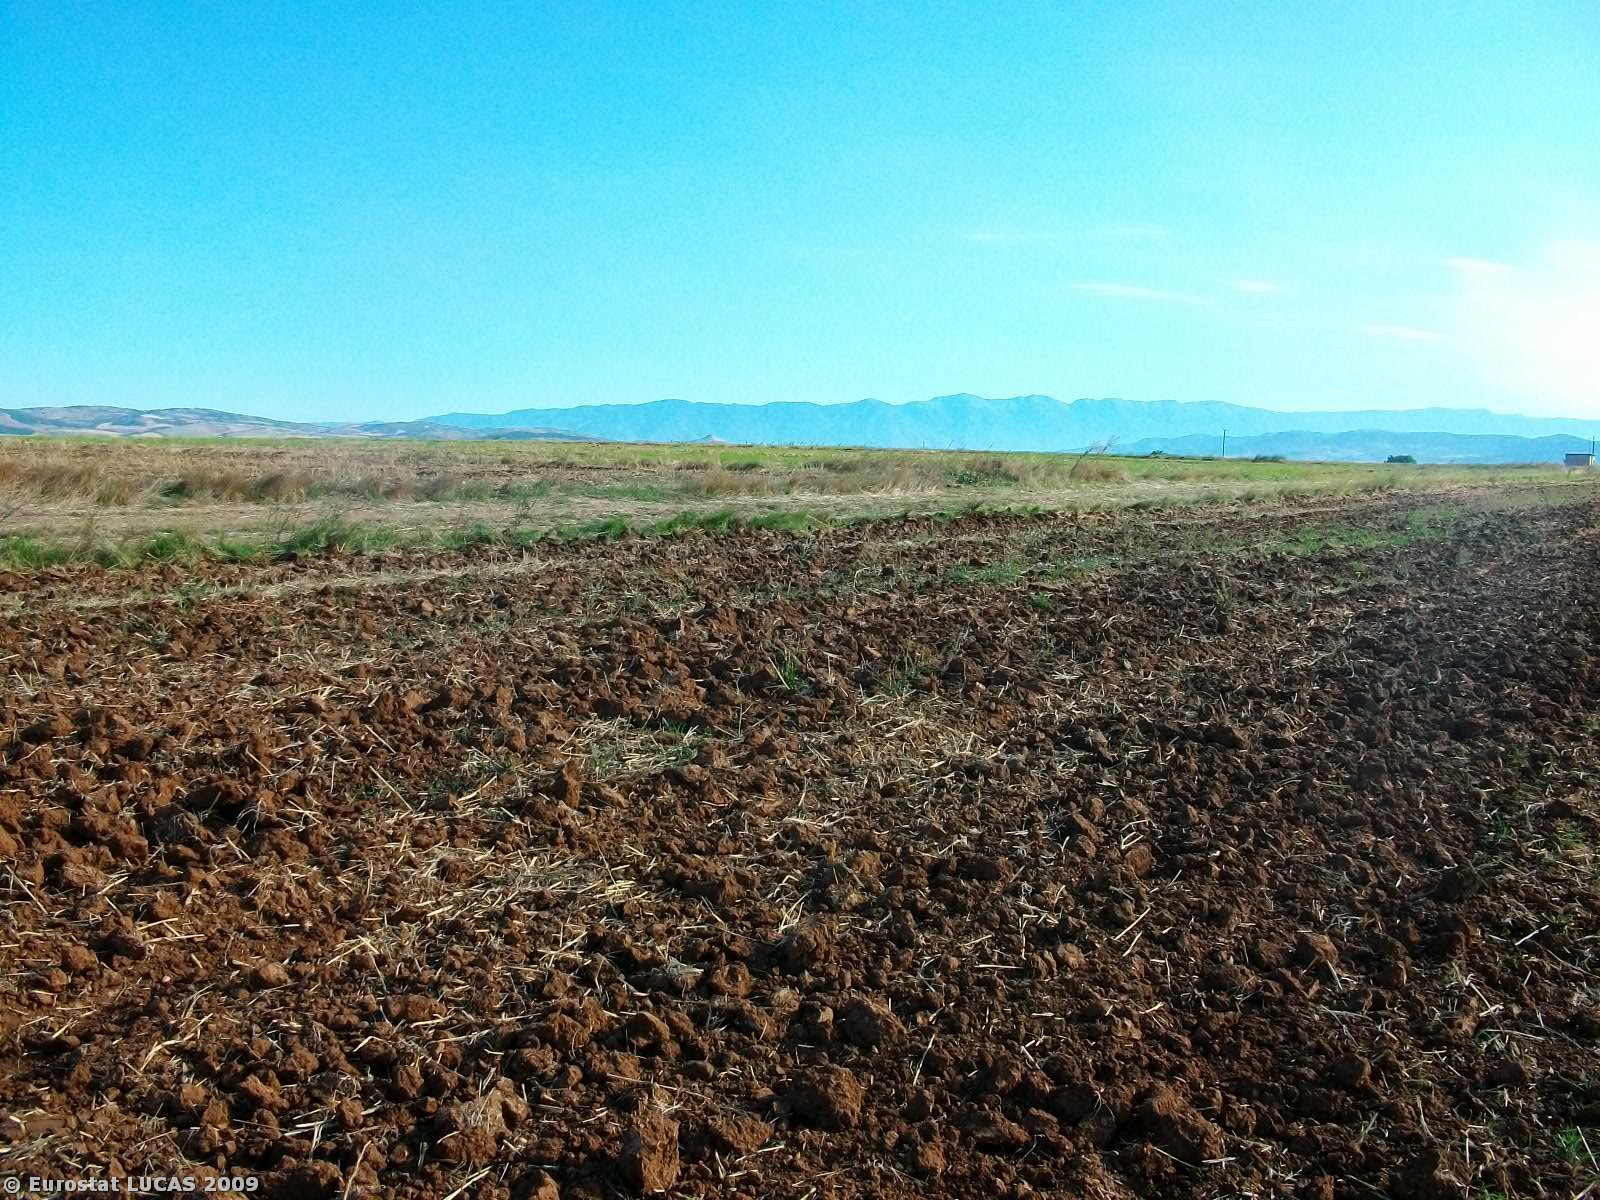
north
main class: Cropland
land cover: Barley
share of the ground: < 10 %
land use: Agriculture (excluding fallow land and kitchen gardens)
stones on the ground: < 10 %
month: July
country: GR
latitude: 41.0408
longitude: 22.7499
